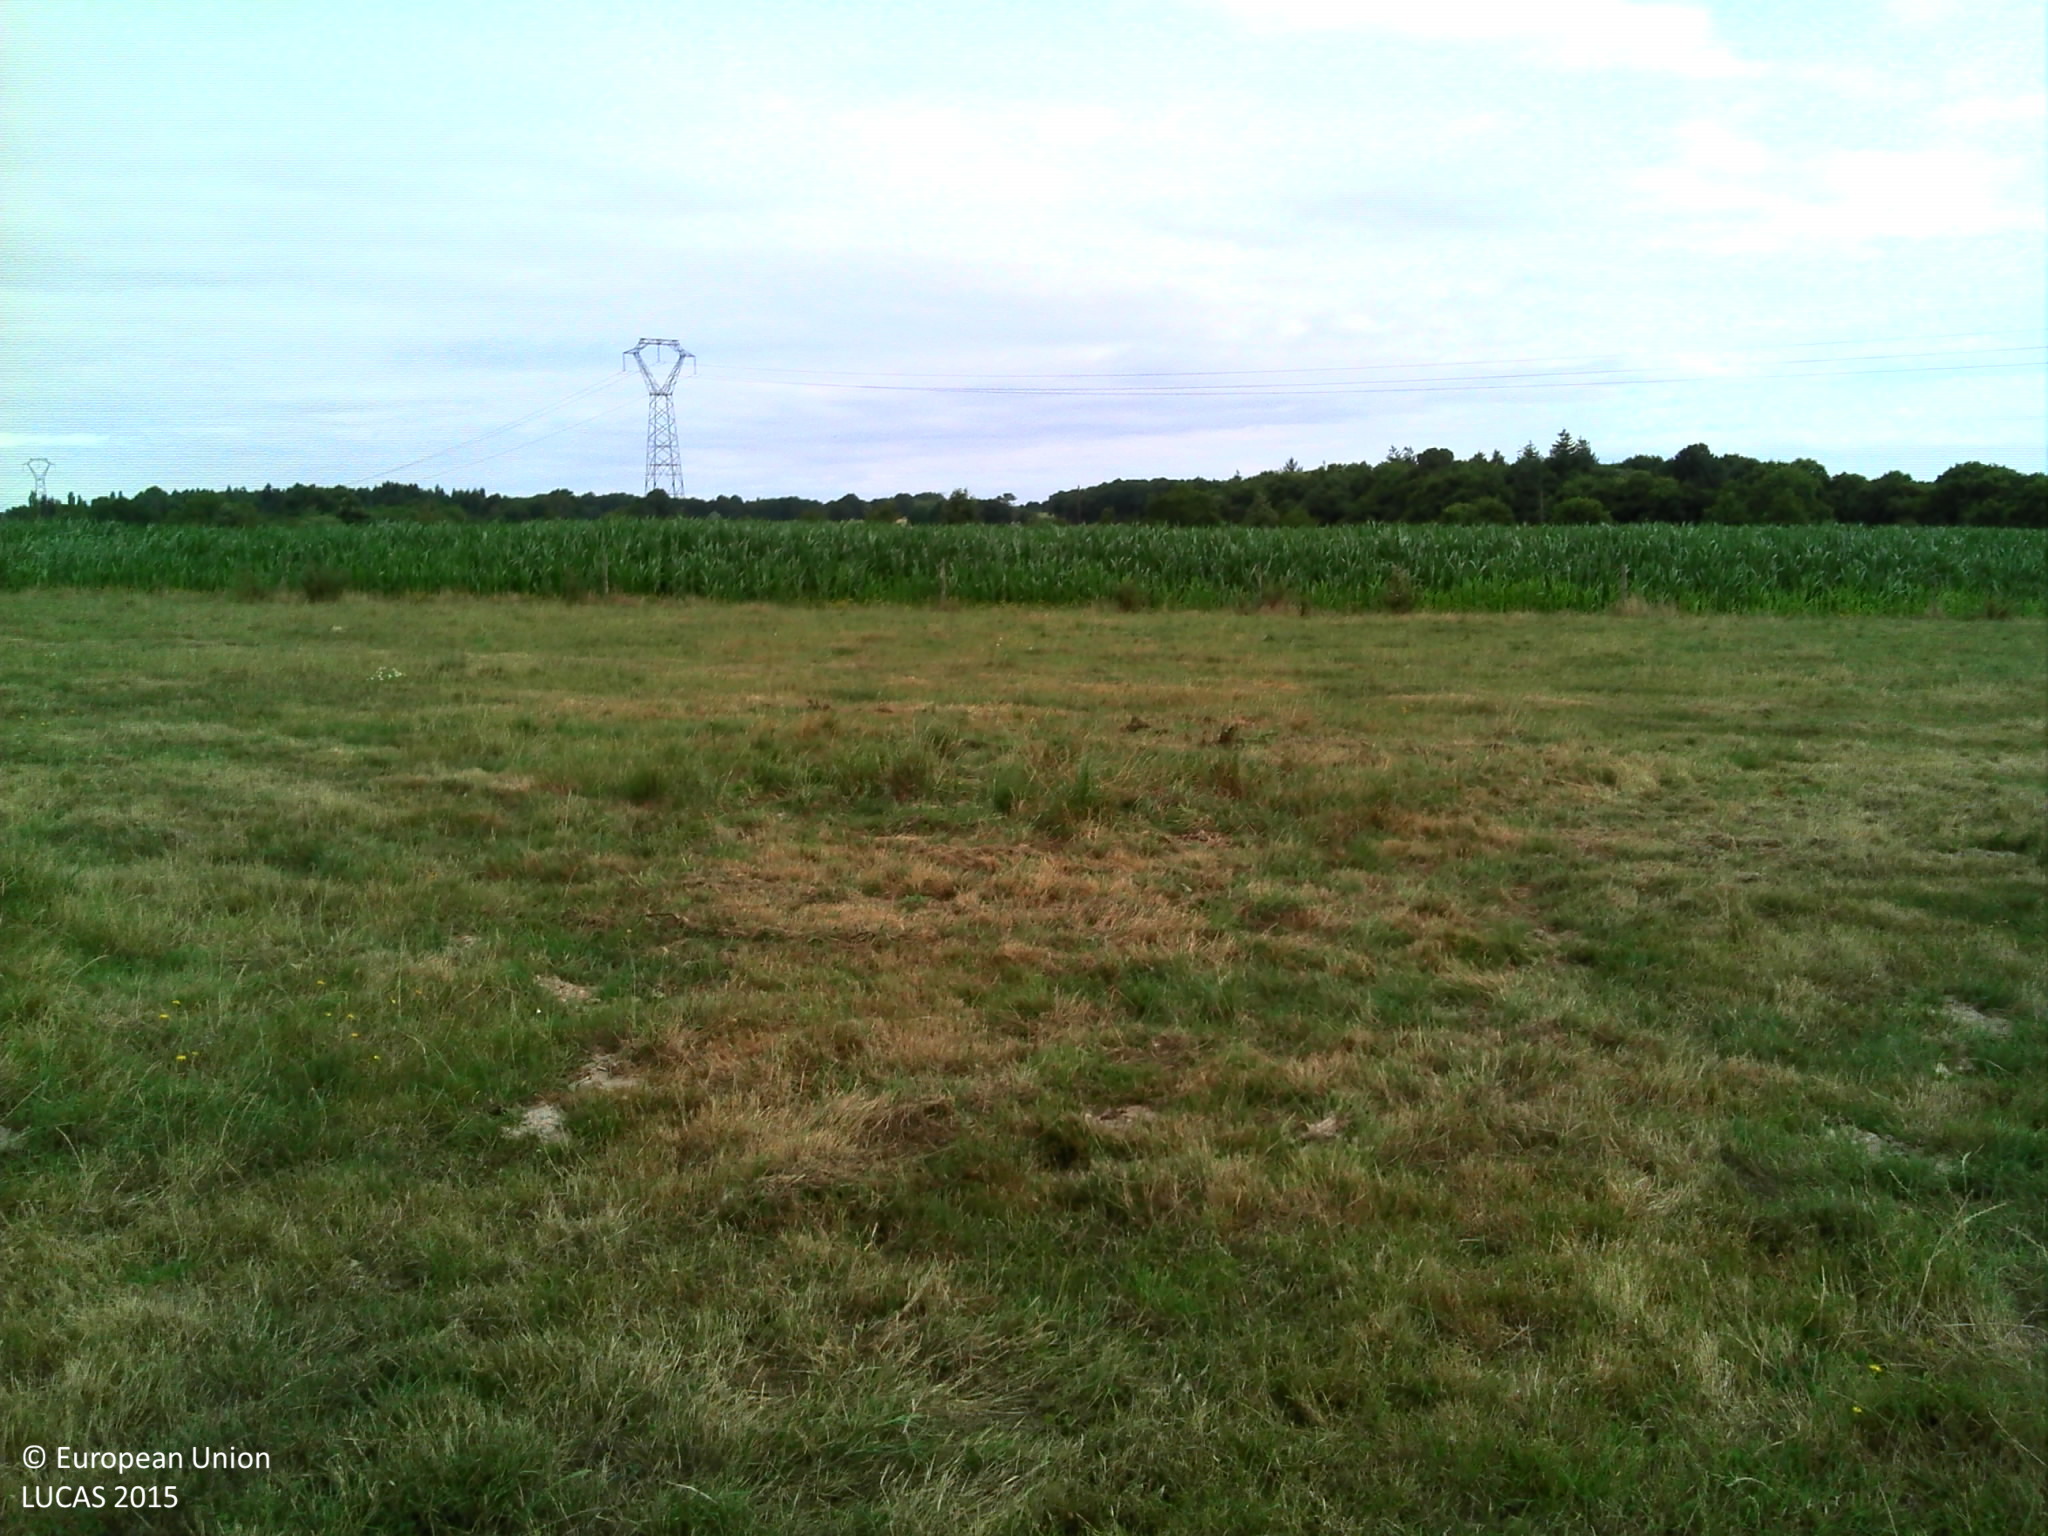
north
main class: Cropland
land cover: Temporary grasslands
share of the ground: > 75 %
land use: Agriculture (excluding fallow land and kitchen gardens)
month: July
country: FR
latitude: 47.4770
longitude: -2.1399
